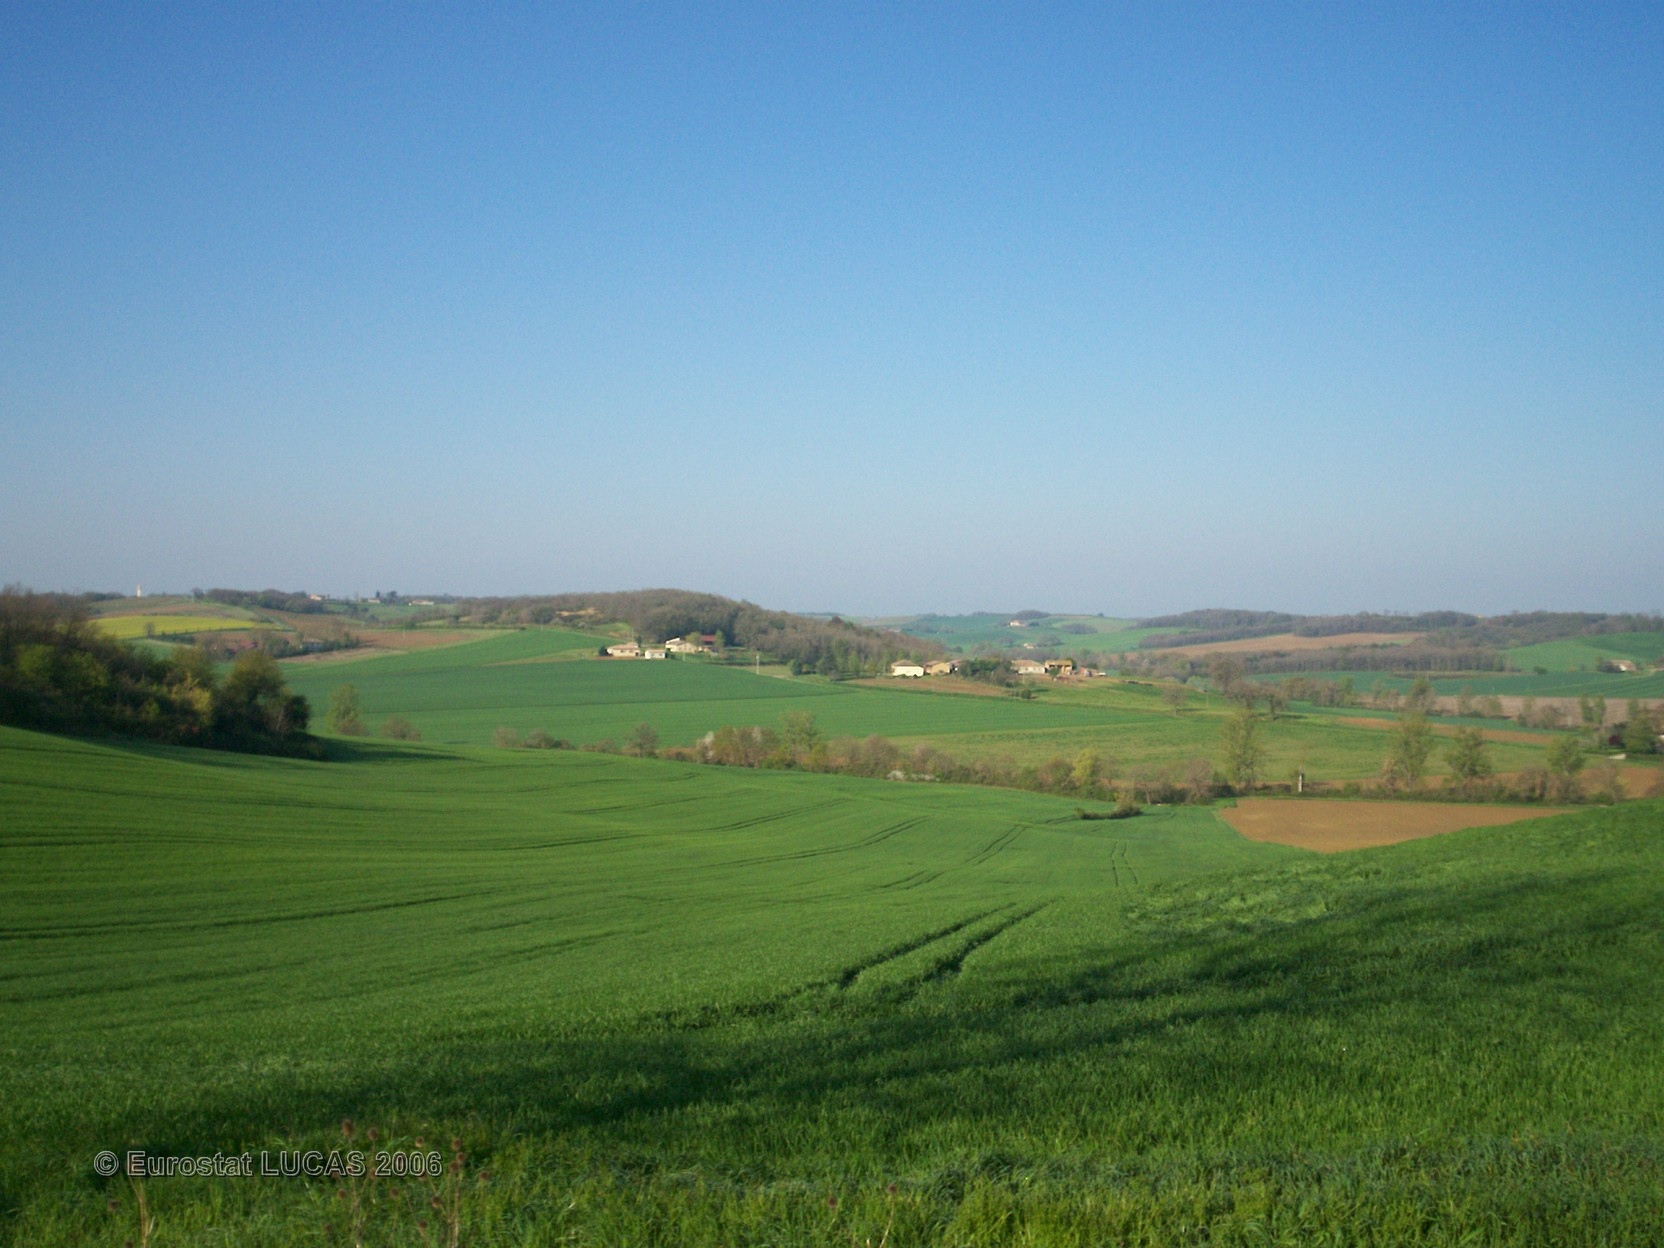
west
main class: Cropland
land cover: Barley
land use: Agriculture (excluding fallow land and kitchen gardens)
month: April
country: FR
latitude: 43.9399
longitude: 0.9910
